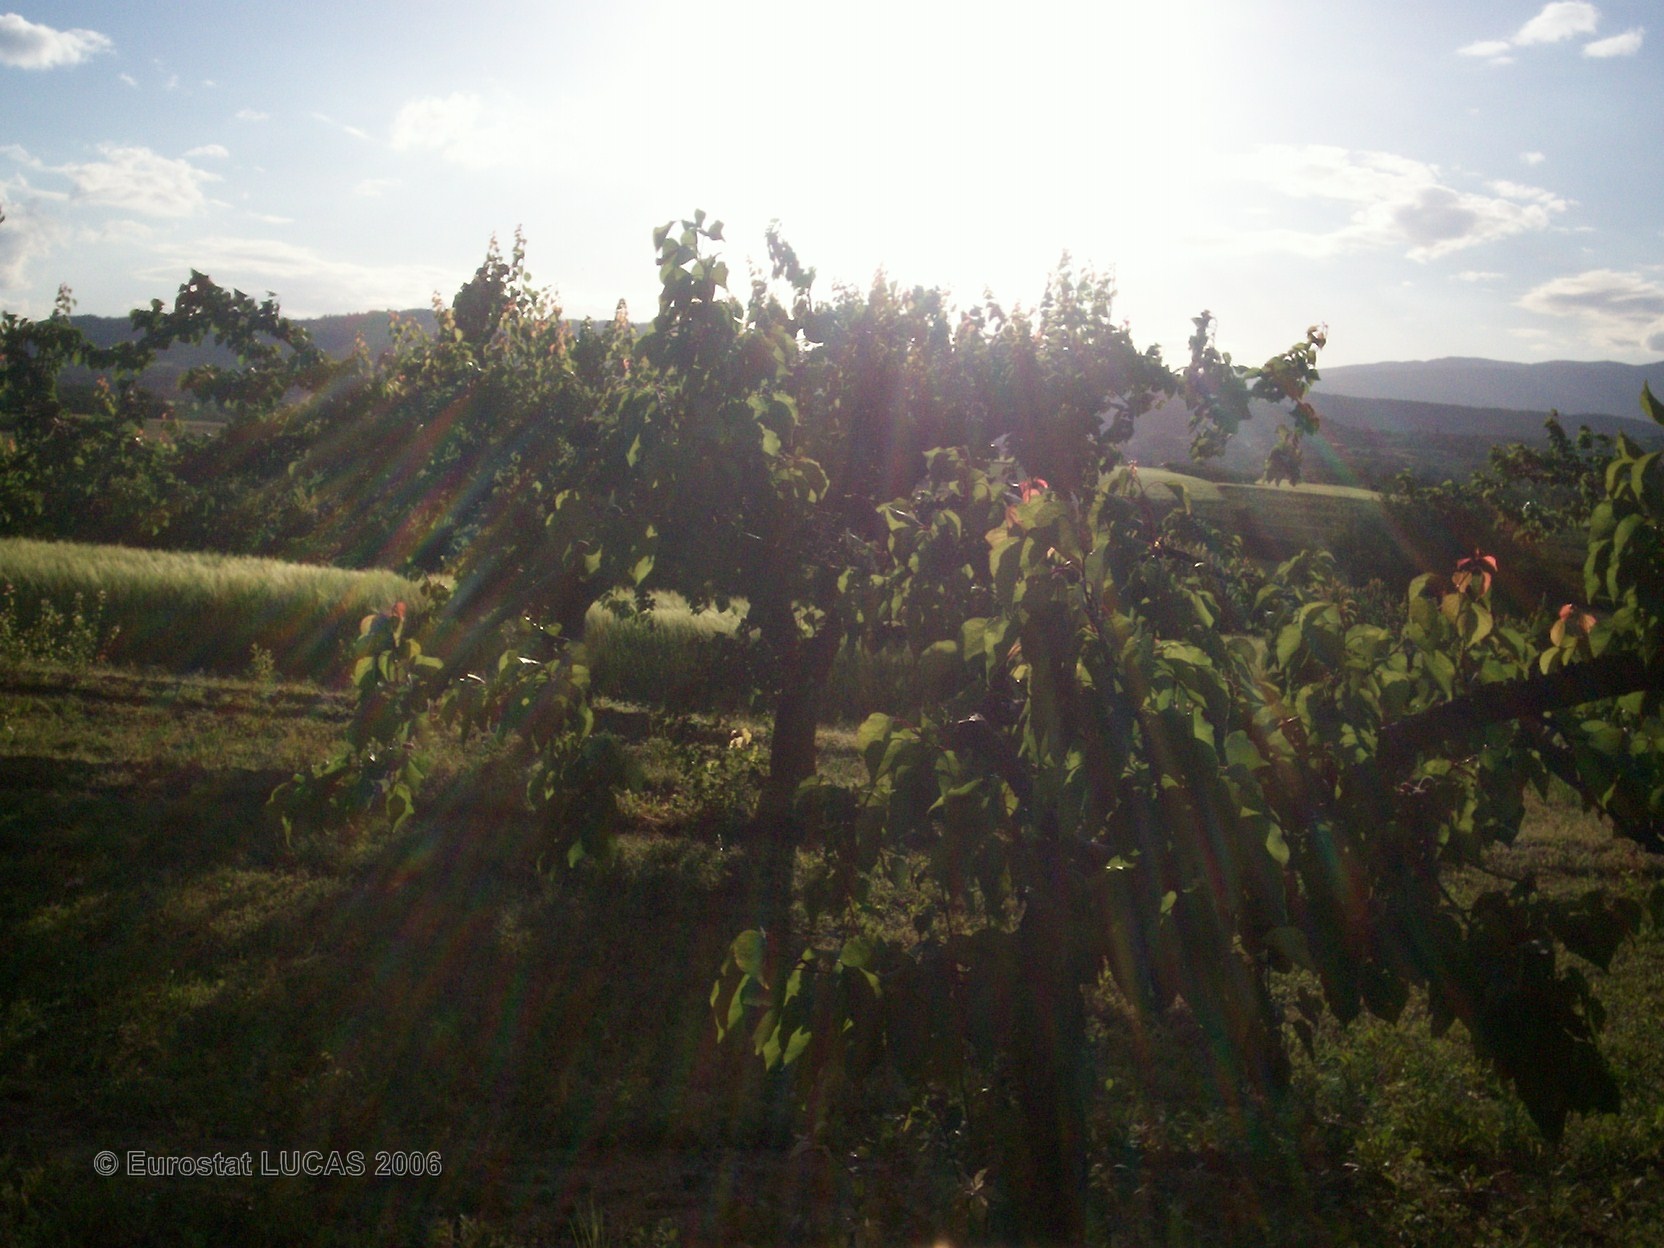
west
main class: Cropland
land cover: Other fruit trees and berries
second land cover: Grassland with sparse tree/shrub cover
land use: Agriculture (excluding fallow land and kitchen gardens)
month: May
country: FR
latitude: 45.3022
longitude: 4.7631
